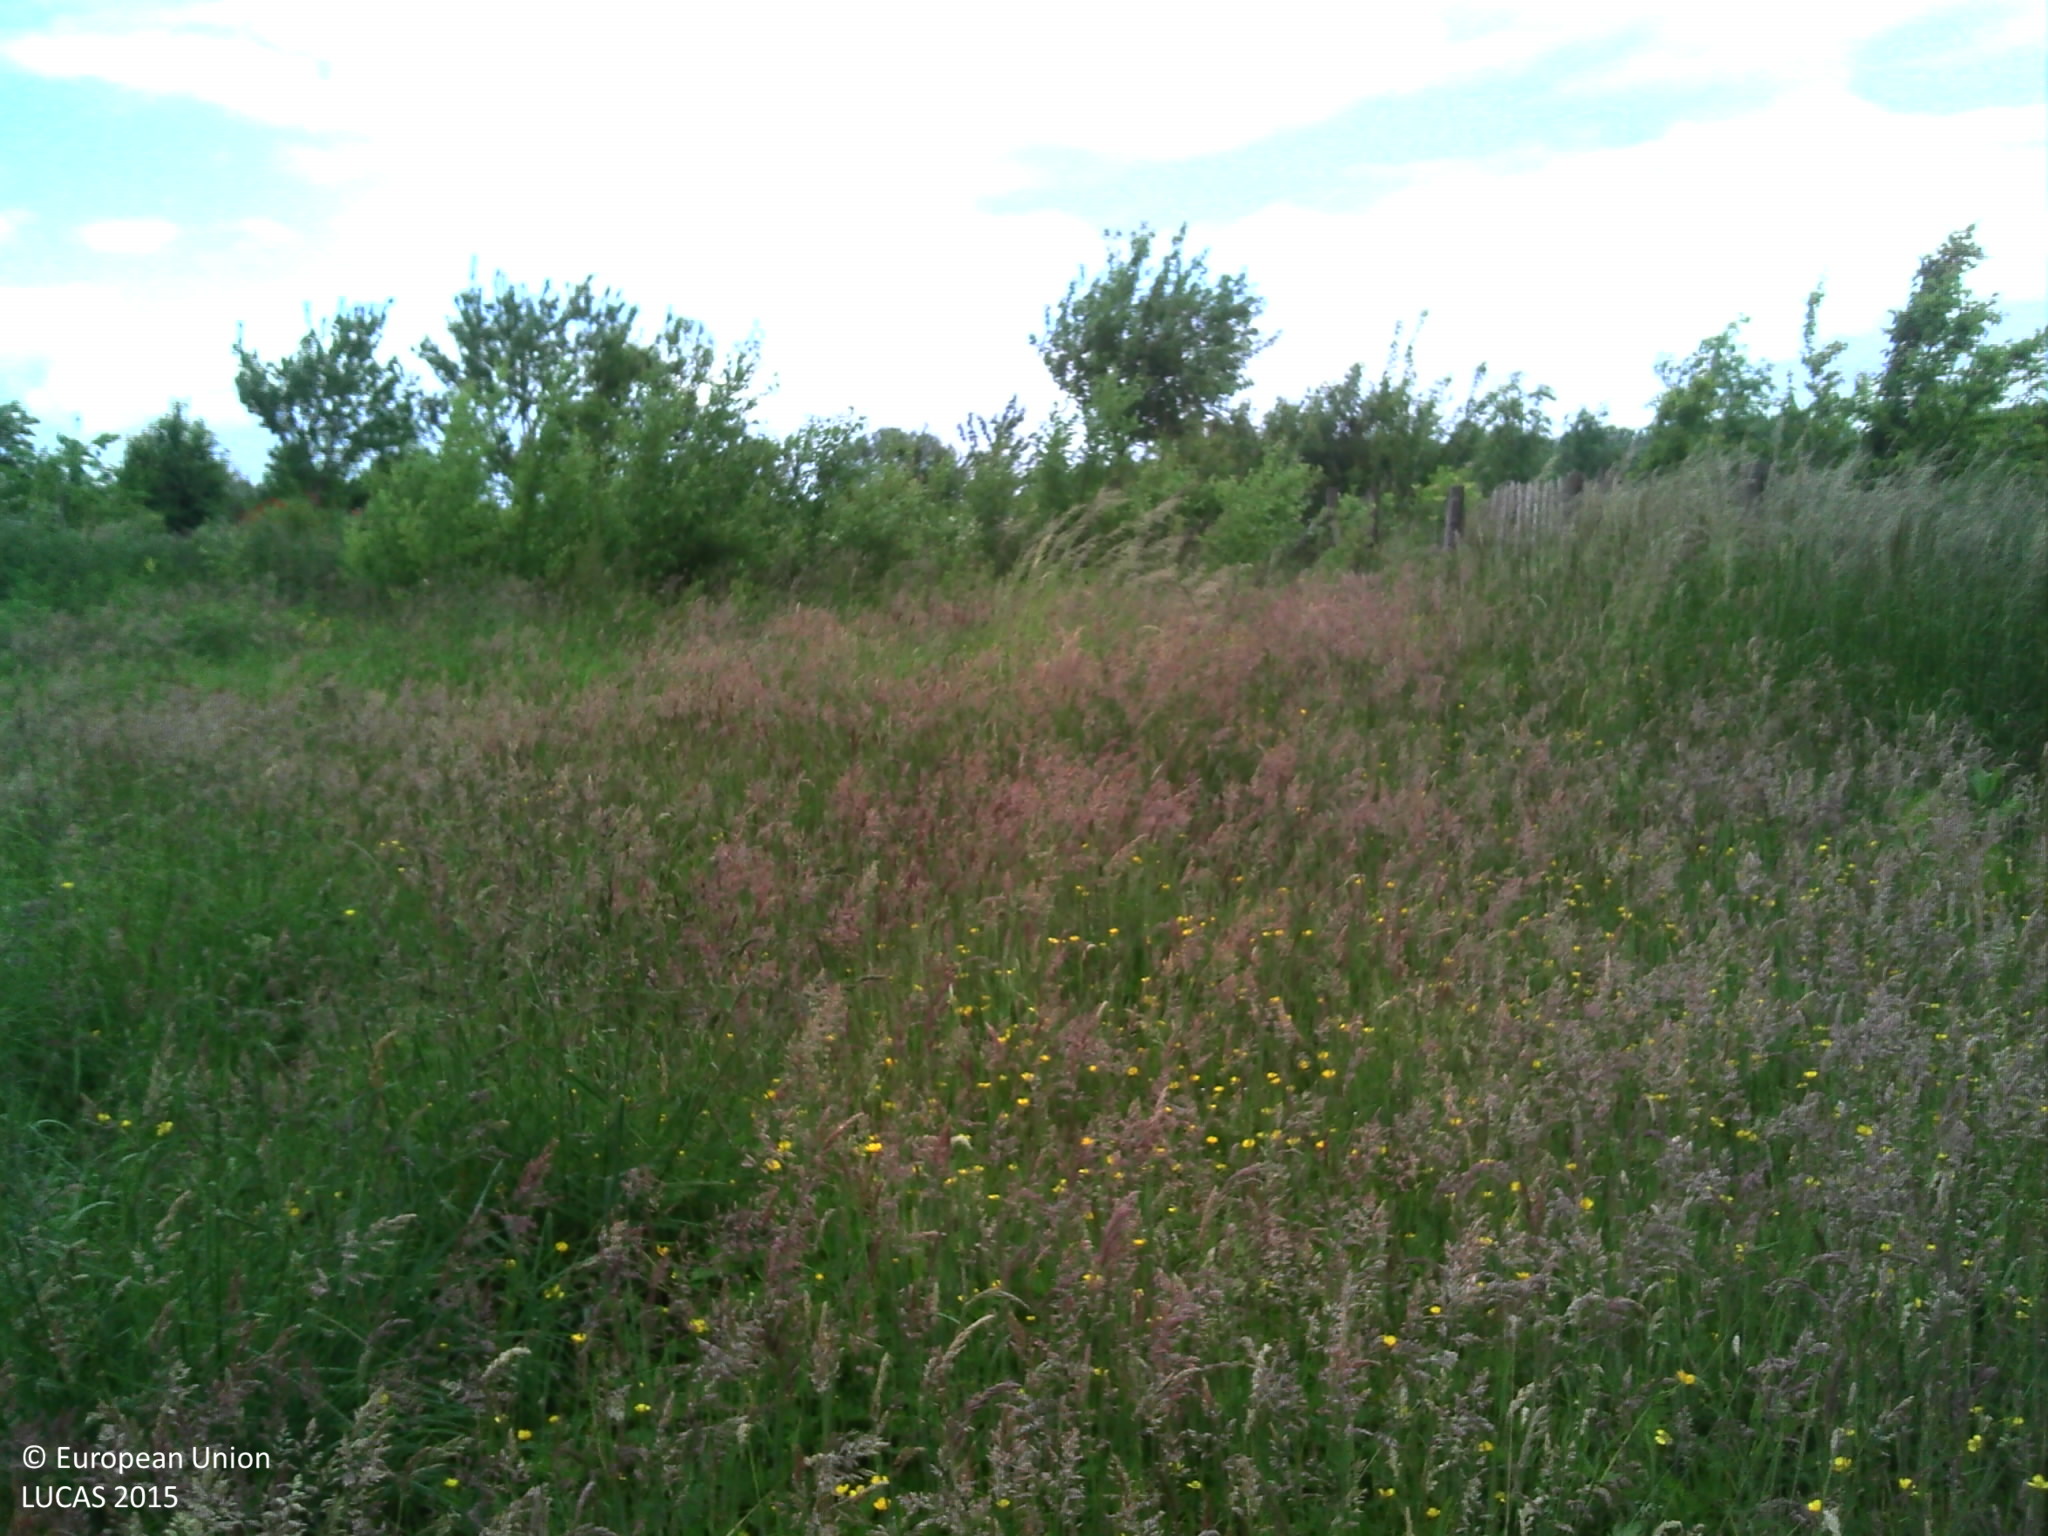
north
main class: Grassland
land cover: Grassland with sparse tree/shrub cover
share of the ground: > 75 %
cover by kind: herbaceous plants 95 %, broadleaved forest trees 5 %
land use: Agriculture (excluding fallow land and kitchen gardens)
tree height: < 5 m
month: June
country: BE
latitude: 50.8728
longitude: 3.9829
